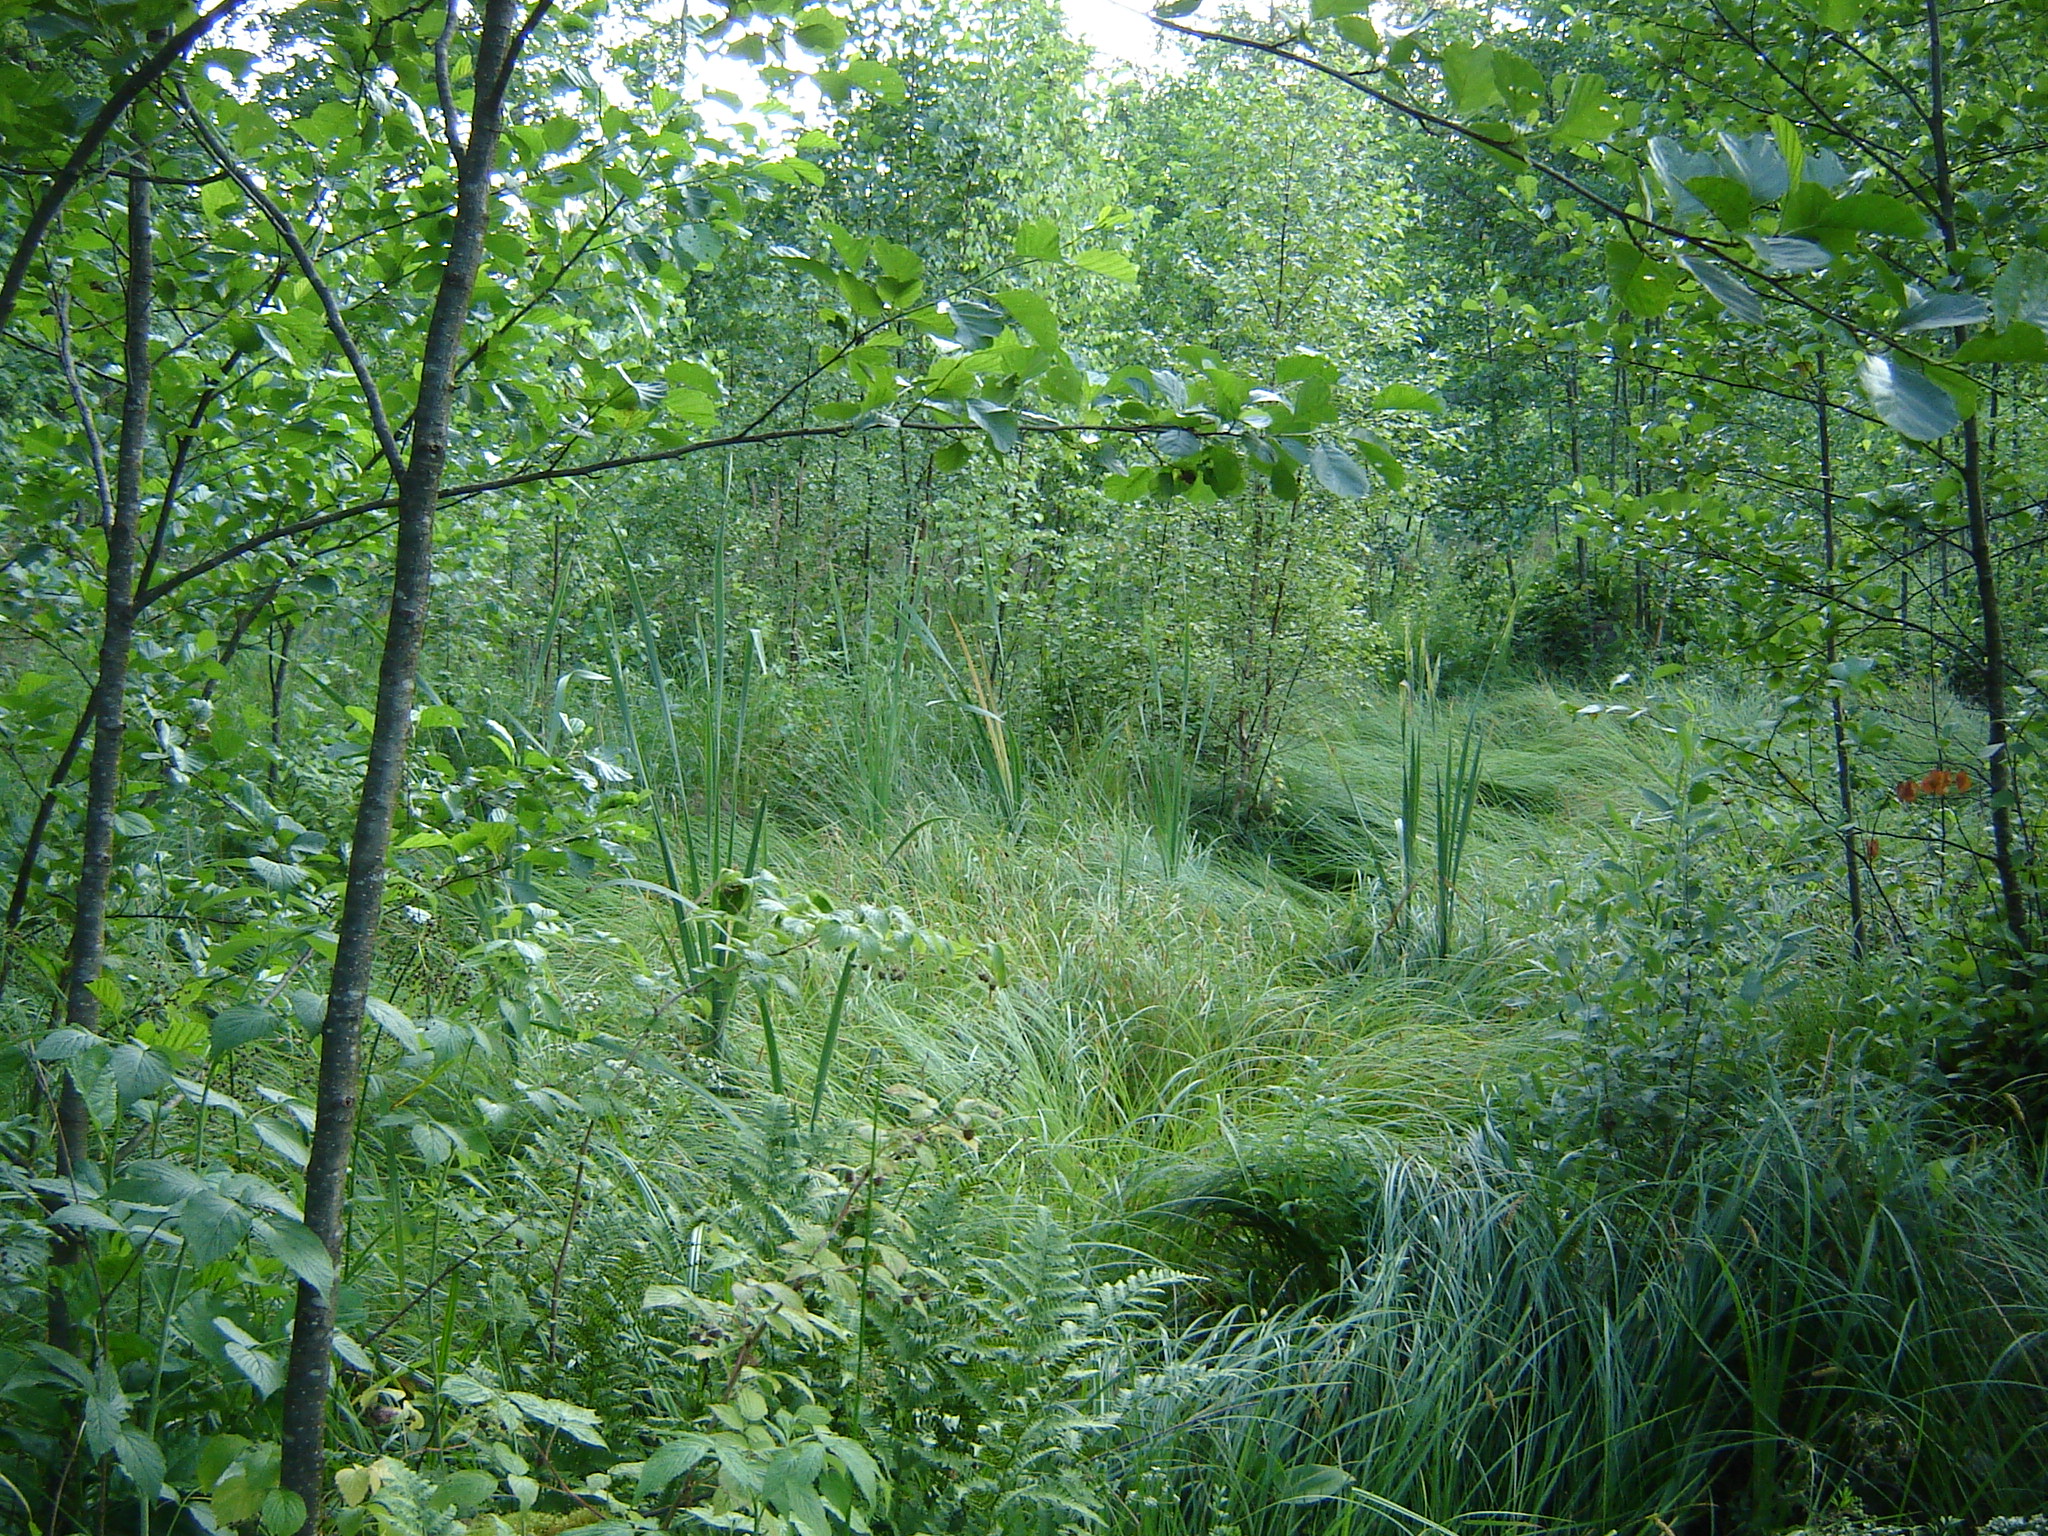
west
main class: Woodland
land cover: Broadleaved woodland
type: non-riverine alder, birch or aspen forest
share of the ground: 50 - 75 %
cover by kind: broadleaved forest trees 70 %, herbaceous plants 30 %
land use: Forestry
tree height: < 5 m
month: July
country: LT
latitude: 55.4485
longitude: 25.5729
